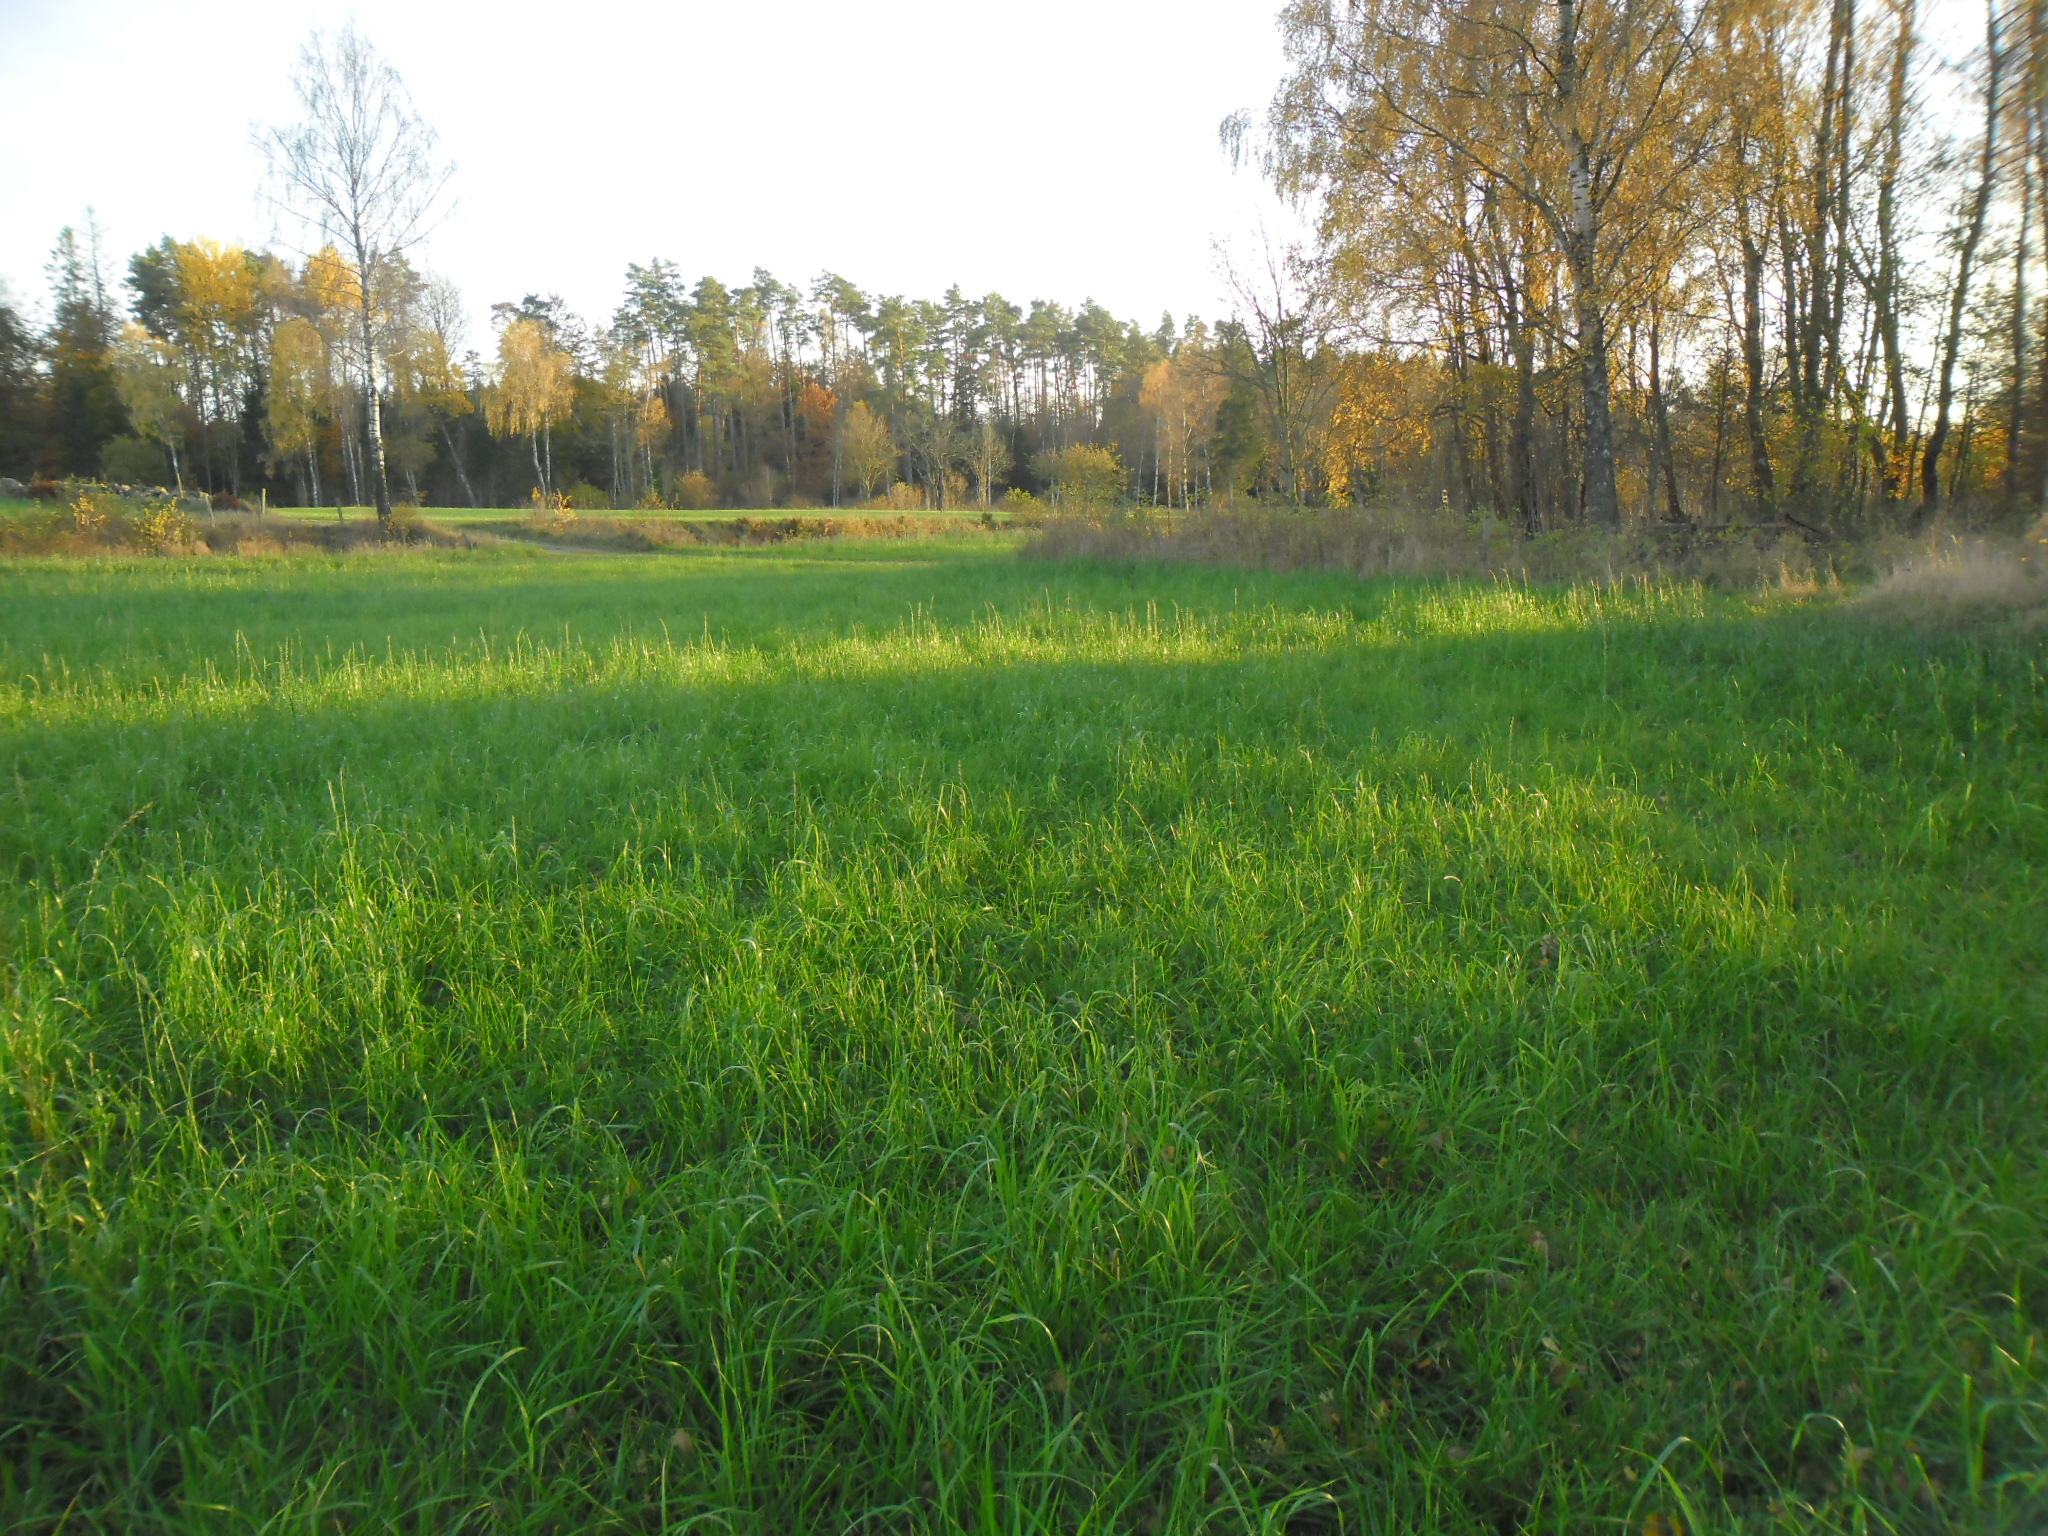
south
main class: Grassland
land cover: Grassland without tree/shrub cover
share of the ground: > 75 %
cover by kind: herbaceous plants 100 %
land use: Agriculture (excluding fallow land and kitchen gardens)
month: October
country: SE
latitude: 56.2059
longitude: 13.7213
